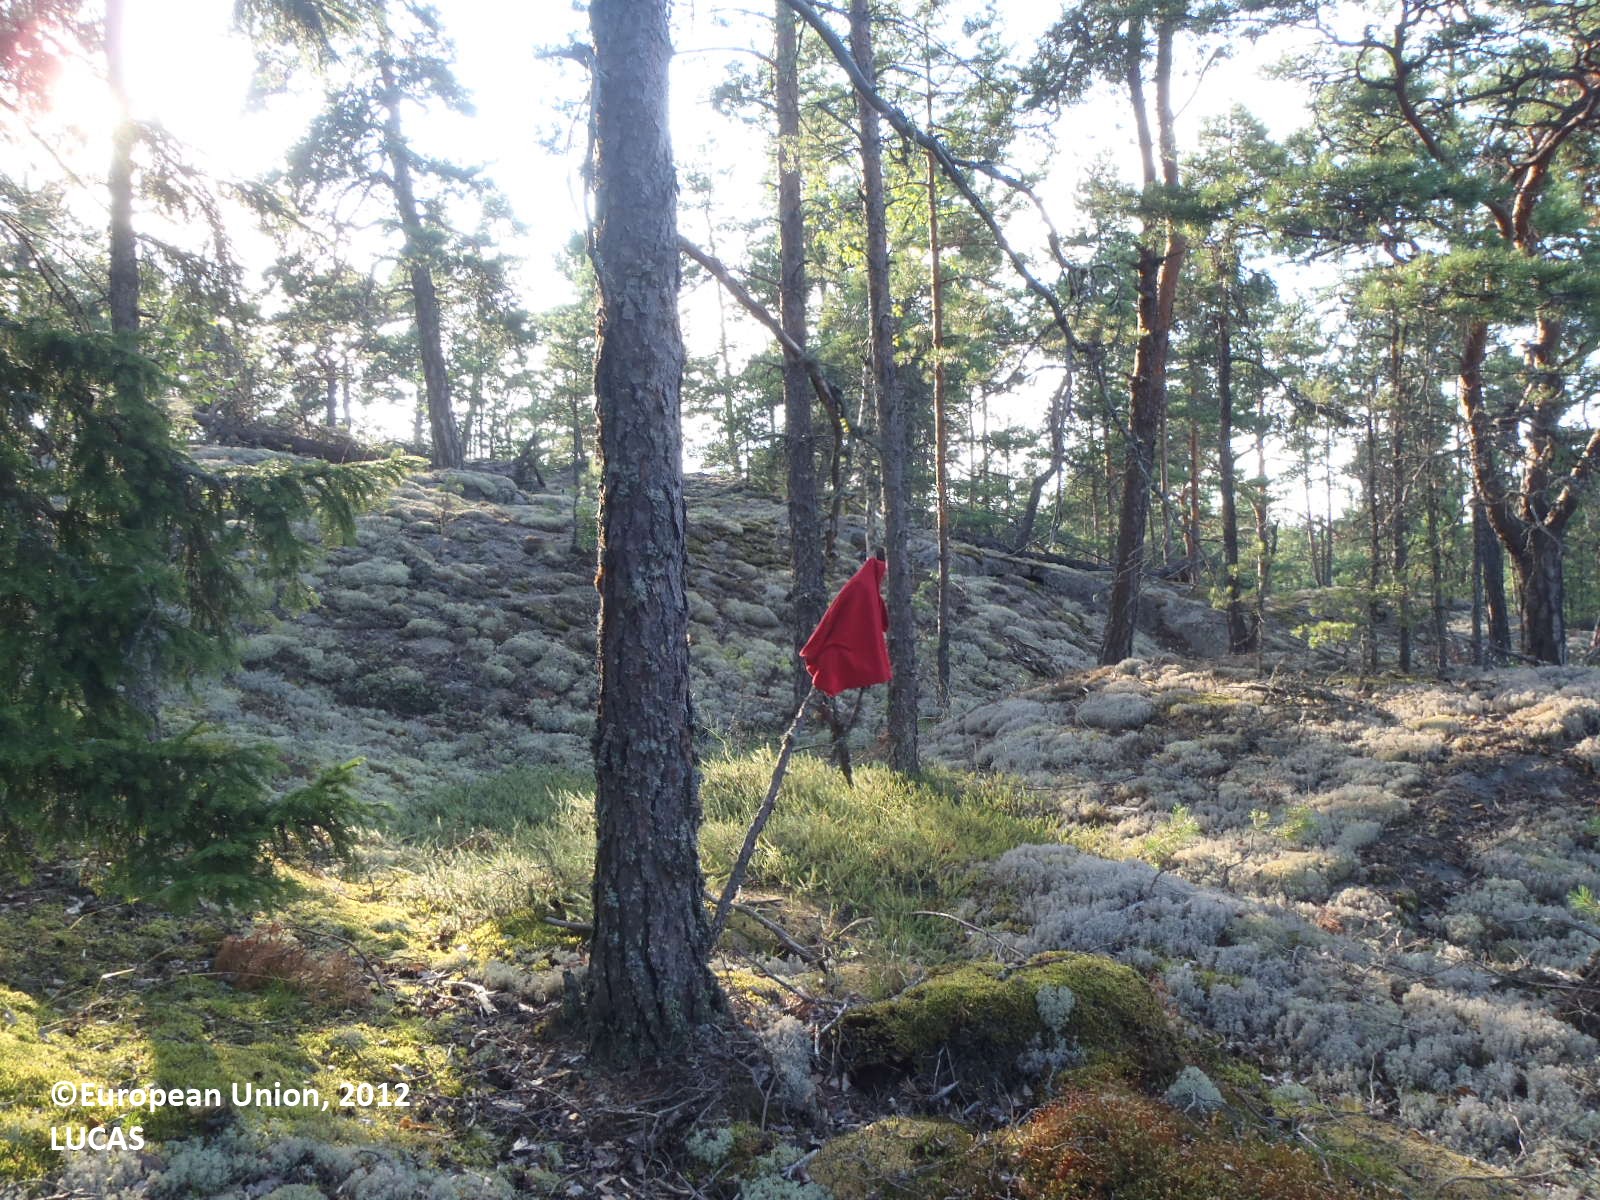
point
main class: Woodland
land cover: Pine dominated coniferous woodland
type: boreal forest
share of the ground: 50 - 75 %
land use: Semi-natural and natural areas not in use
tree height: > 5 m
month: July
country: FI
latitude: 60.5509
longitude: 21.6737
